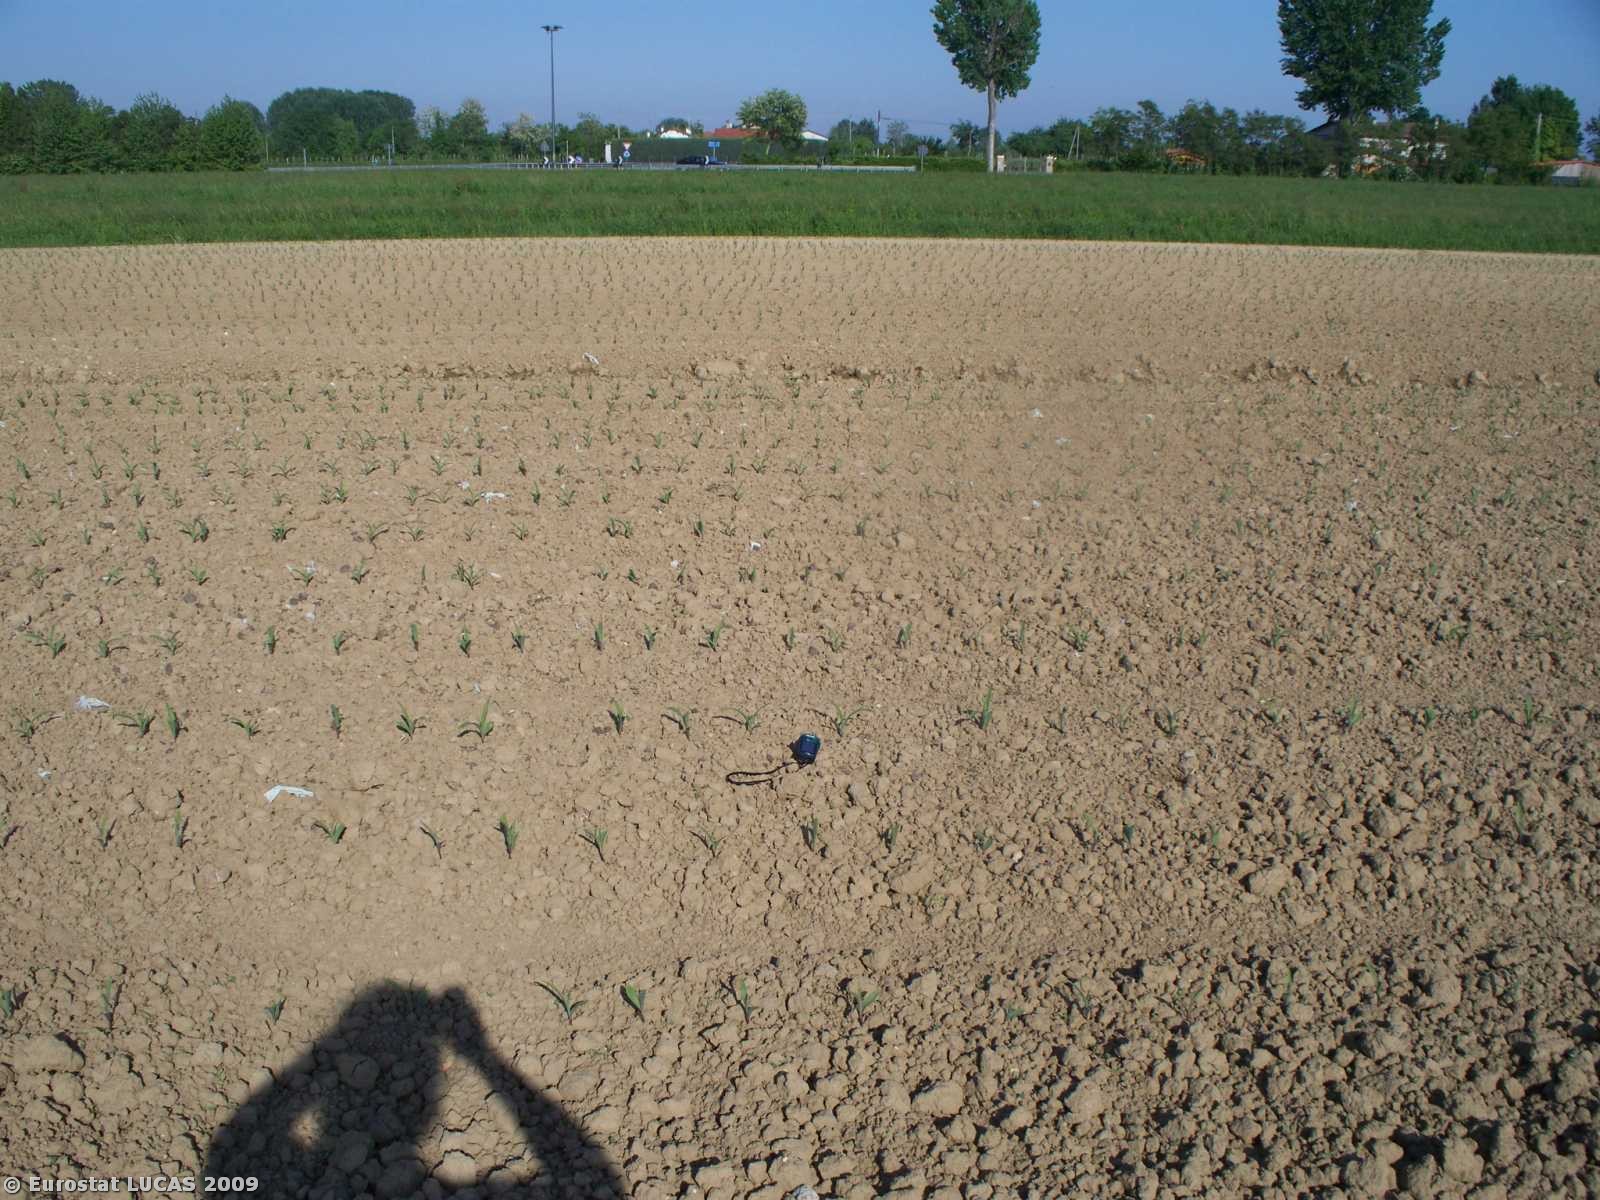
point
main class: Cropland
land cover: Maize
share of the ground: < 10 %
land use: Agriculture (excluding fallow land and kitchen gardens)
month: May
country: IT
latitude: 45.5199
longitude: 12.0835
